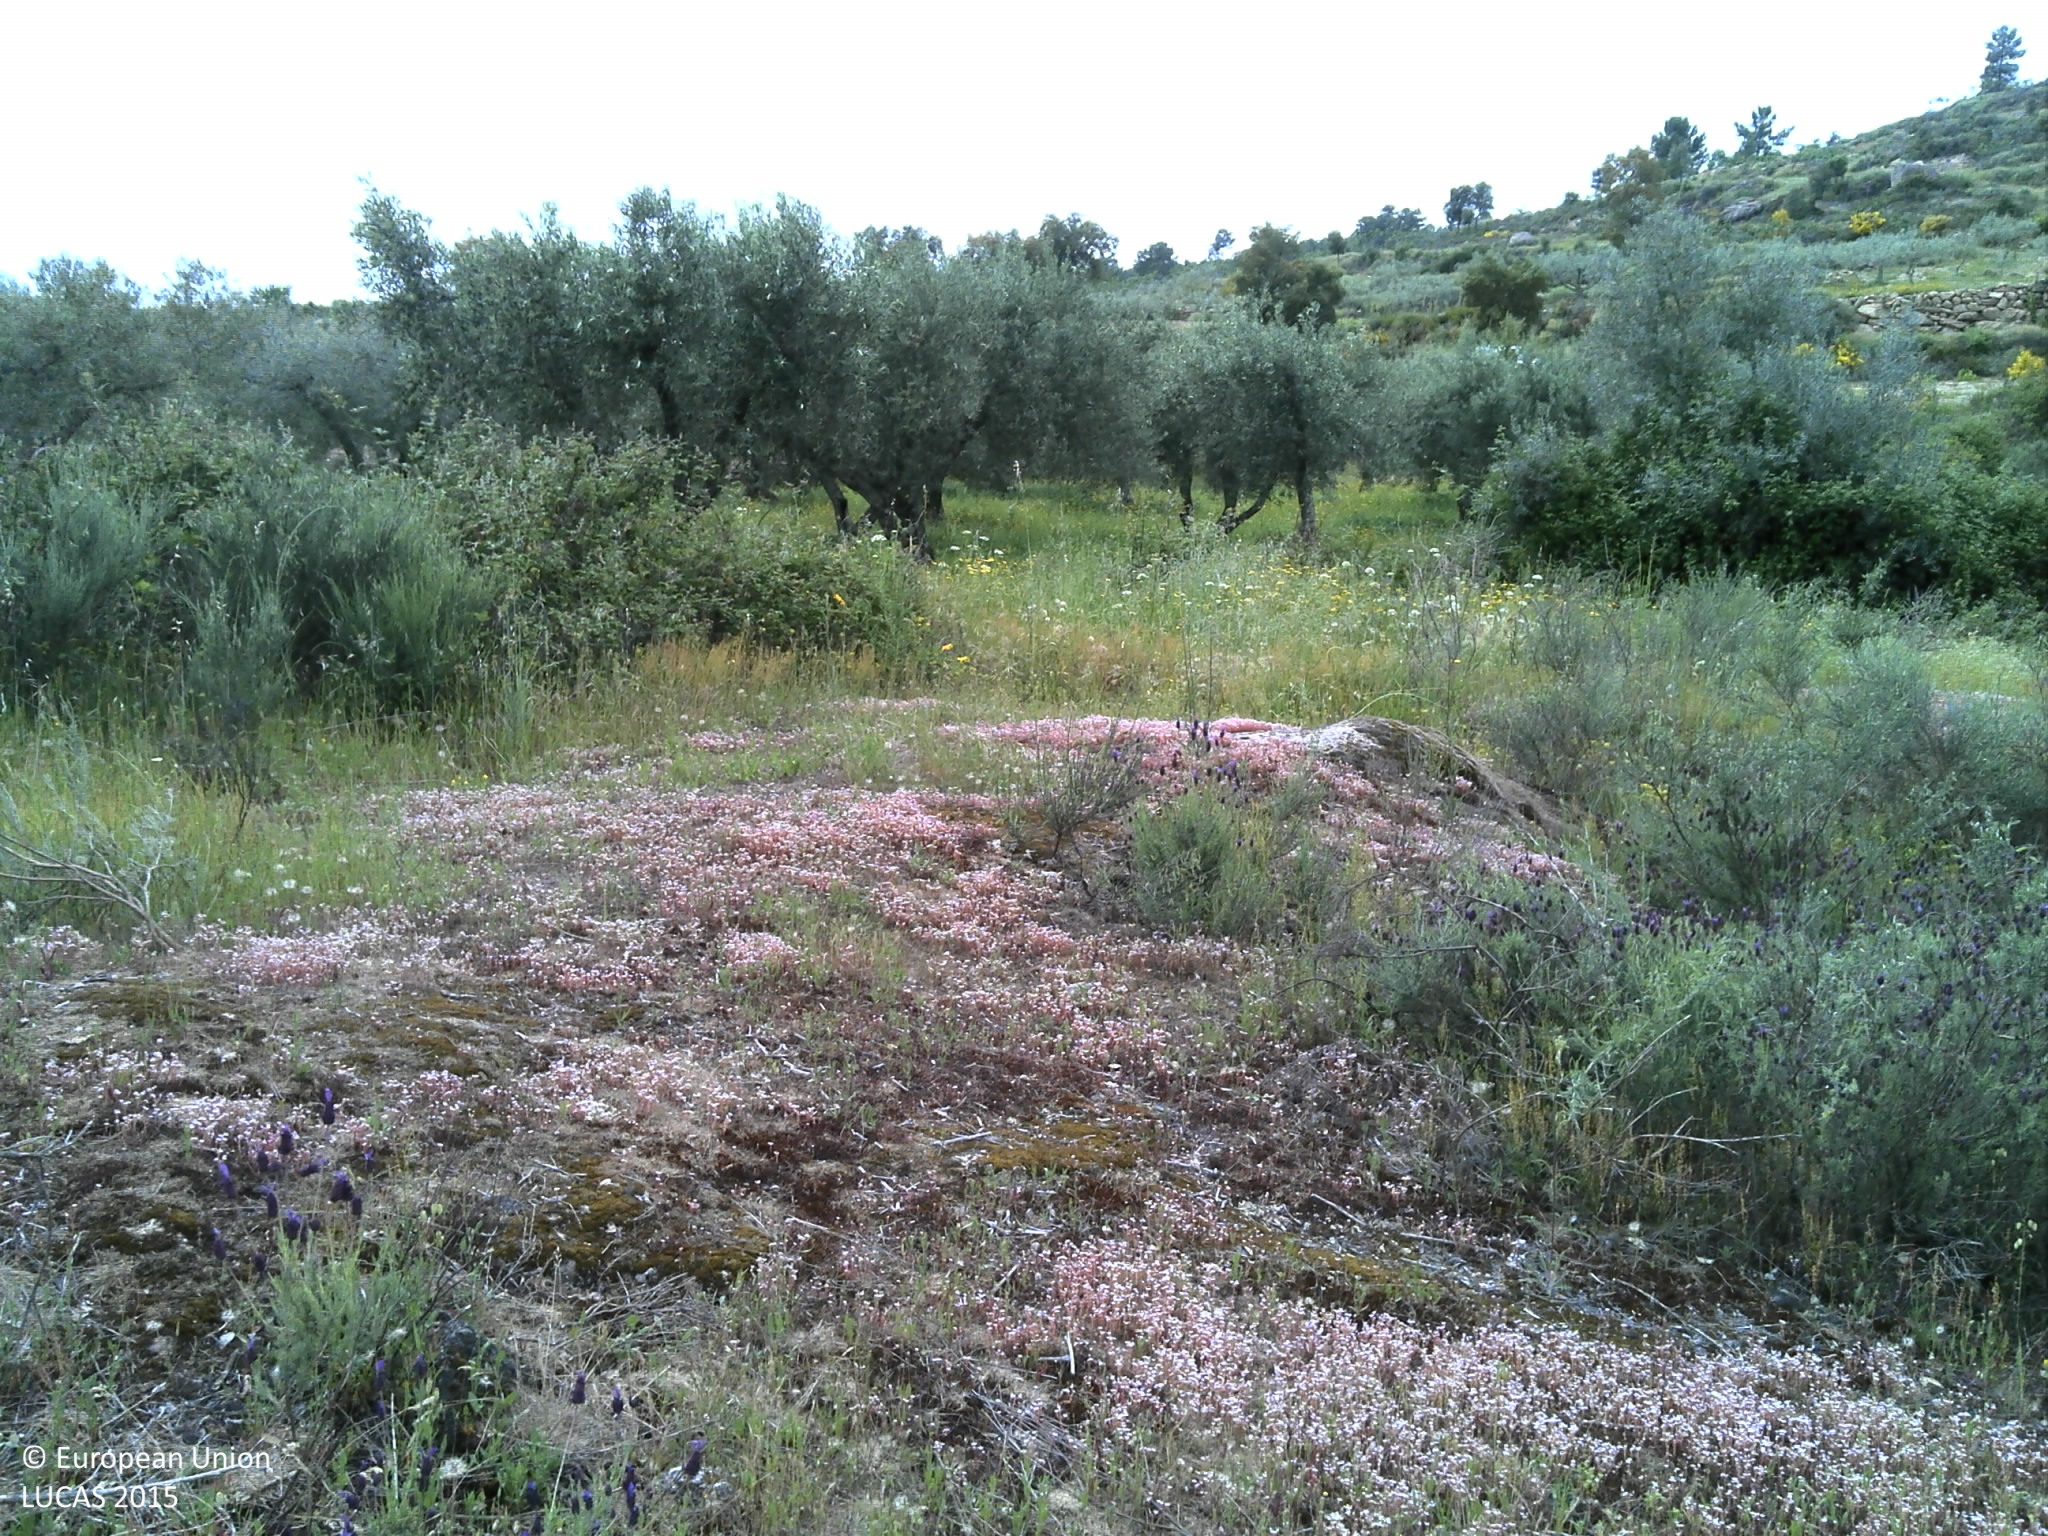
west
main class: Shrubland
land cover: Shrubland with sparse tree cover
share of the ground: > 75 %
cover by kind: shrubs 90 %, broadleaved forest trees 5 %, unconsolidated bare surface 5 %
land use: Abandoned areas
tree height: > 5 m
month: May
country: PT
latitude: 41.6731
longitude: -7.1656
